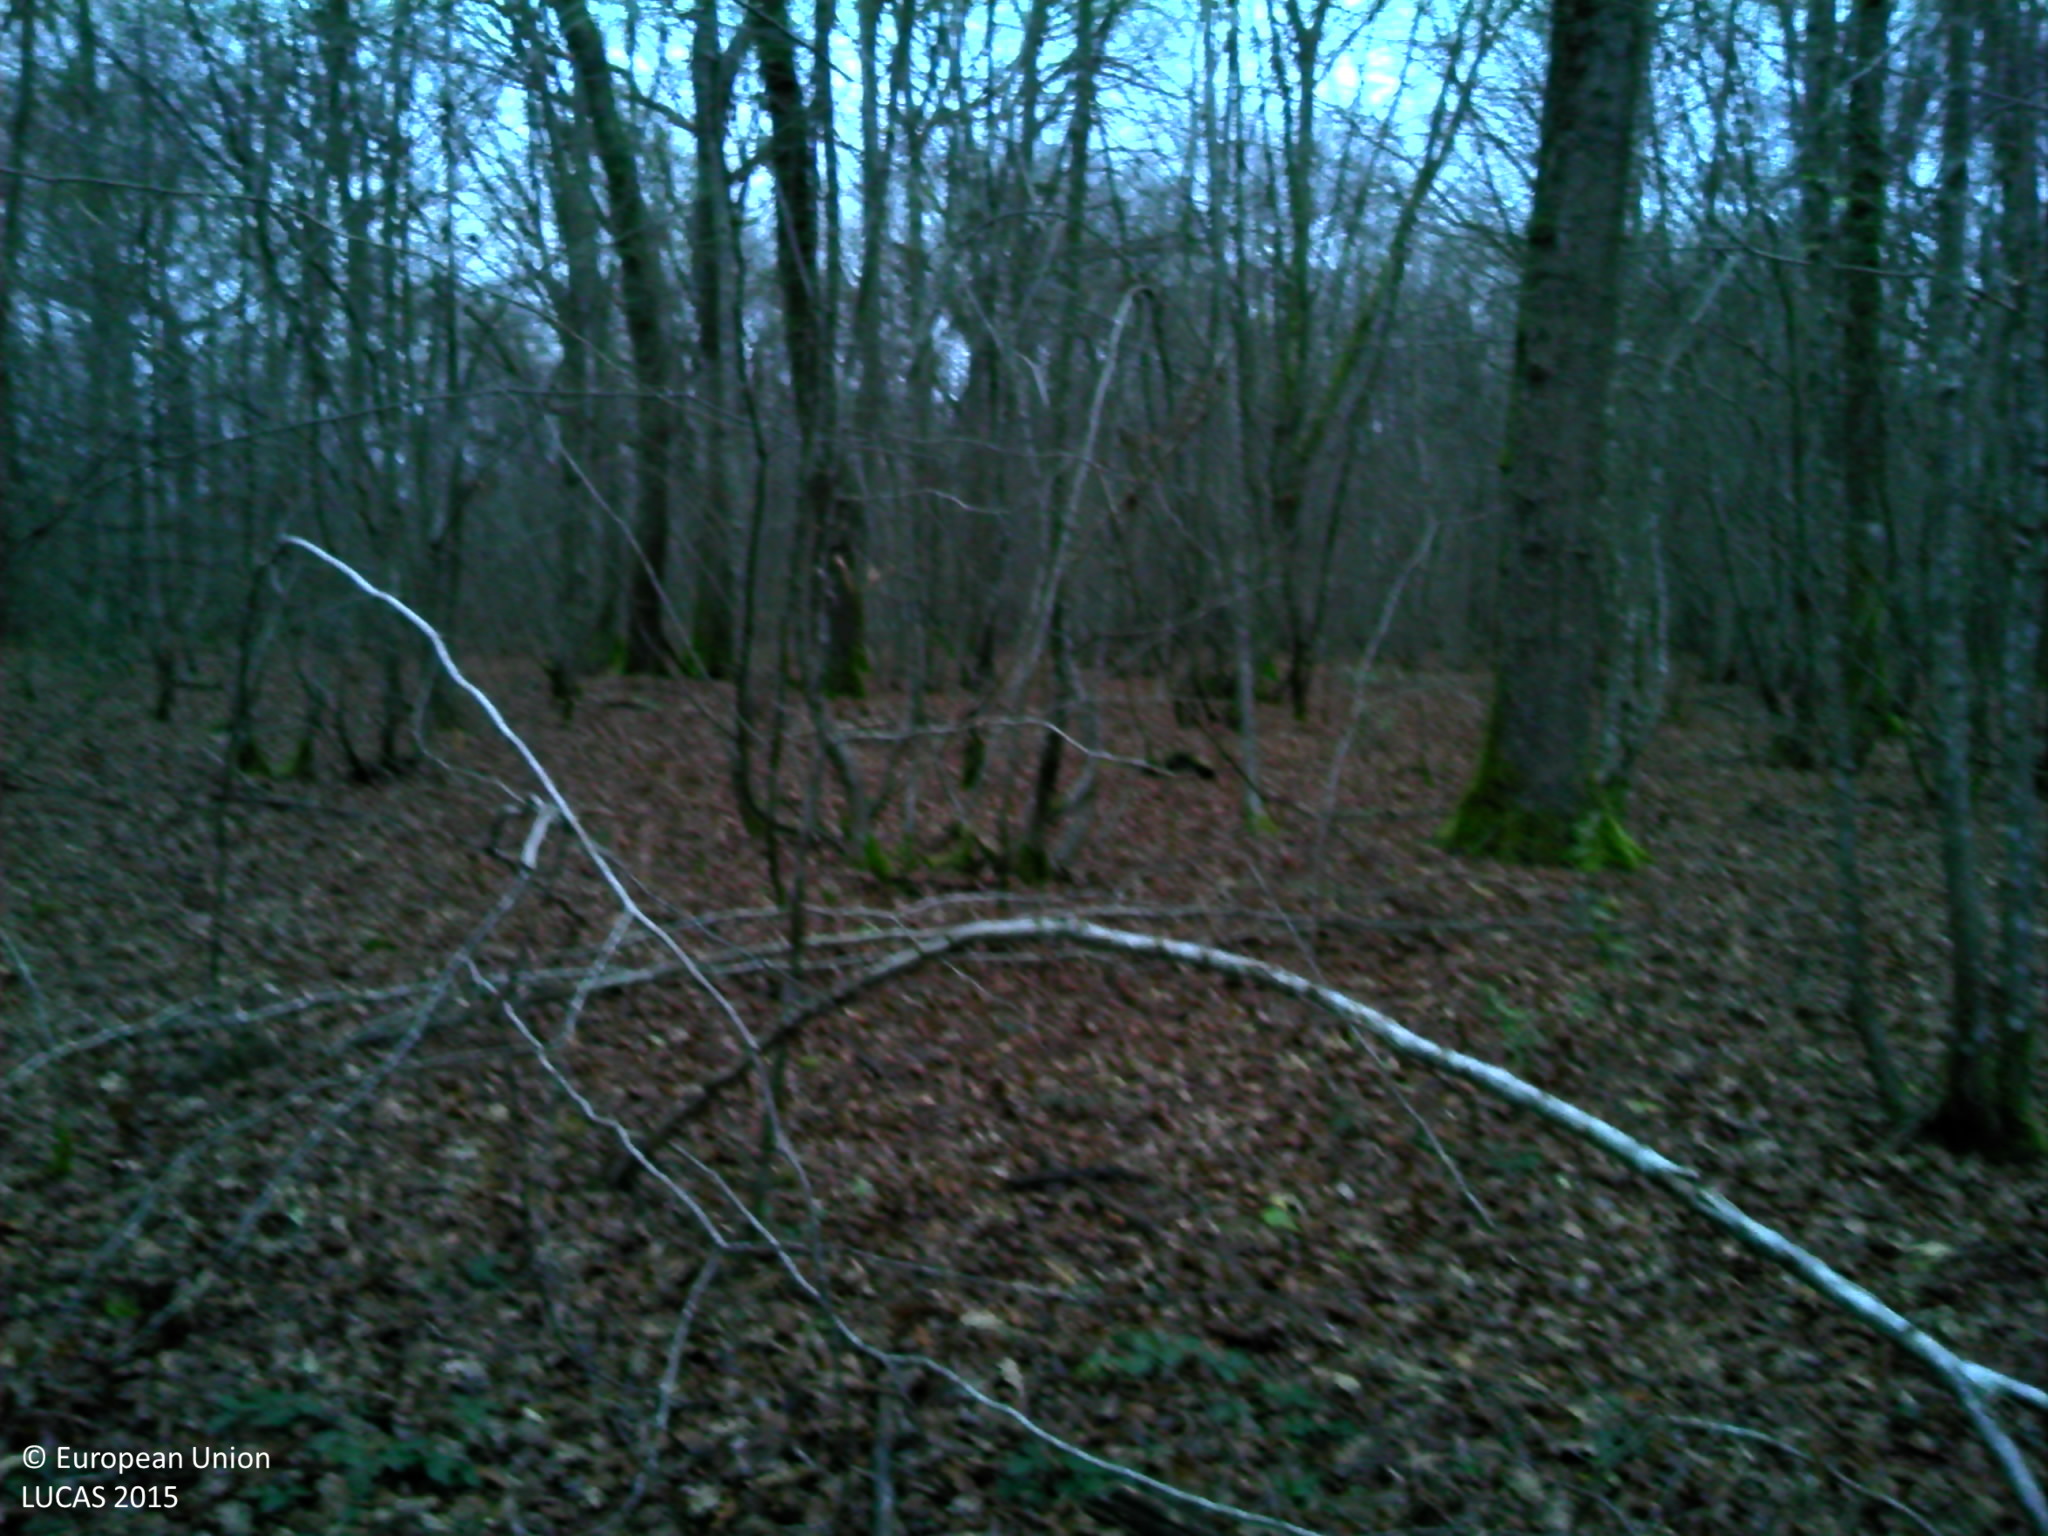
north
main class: Woodland
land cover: Broadleaved woodland
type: acidophilous oak and oak-birch forest
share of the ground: > 75 %
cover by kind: broadleaved forest trees 95 %, shrubs 5 %
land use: Forestry
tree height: > 5 m
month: December
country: FR
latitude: 46.5880
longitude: 3.2241
